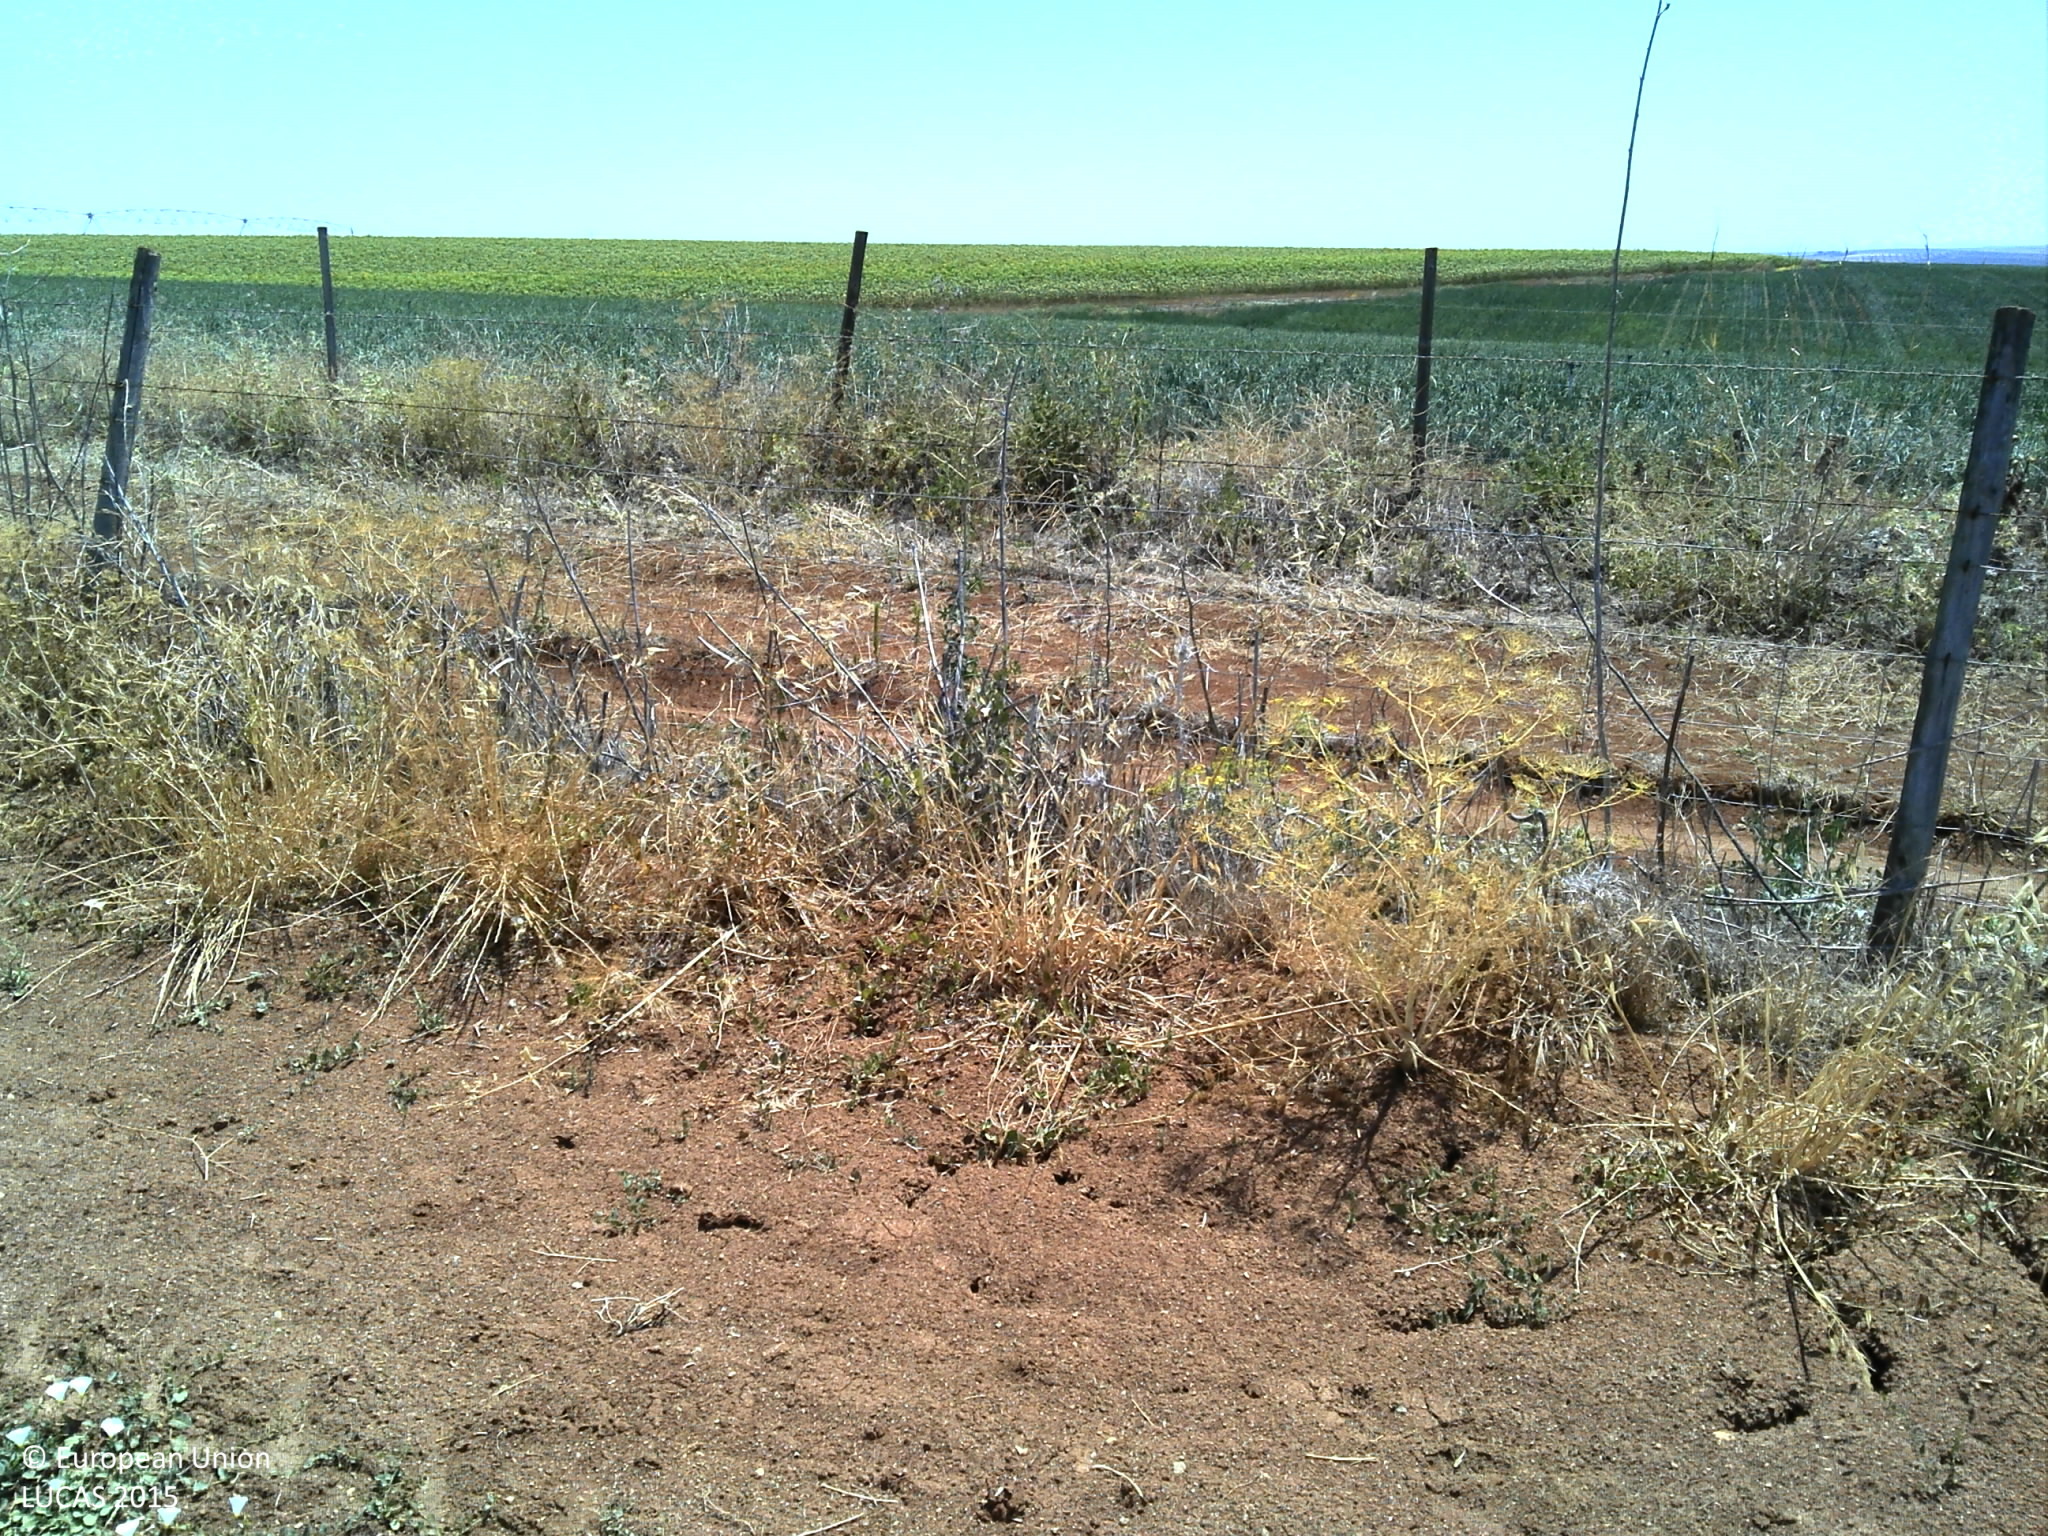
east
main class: Grassland
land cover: Grassland without tree/shrub cover
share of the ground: 25 - 50 %
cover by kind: unconsolidated bare surface 55 %, herbaceous plants 40 %, shrubs 5 %
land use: Agriculture (excluding fallow land and kitchen gardens)
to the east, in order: Grassland without tree/shrub cover; Fences; Grass margins; Tracks; Grass margins; Fences; Grass margins; Tracks; Other fresh vegetables; Grass margins; Tracks; Sunflower
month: June
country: PT
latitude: 38.0118
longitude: -7.6192
